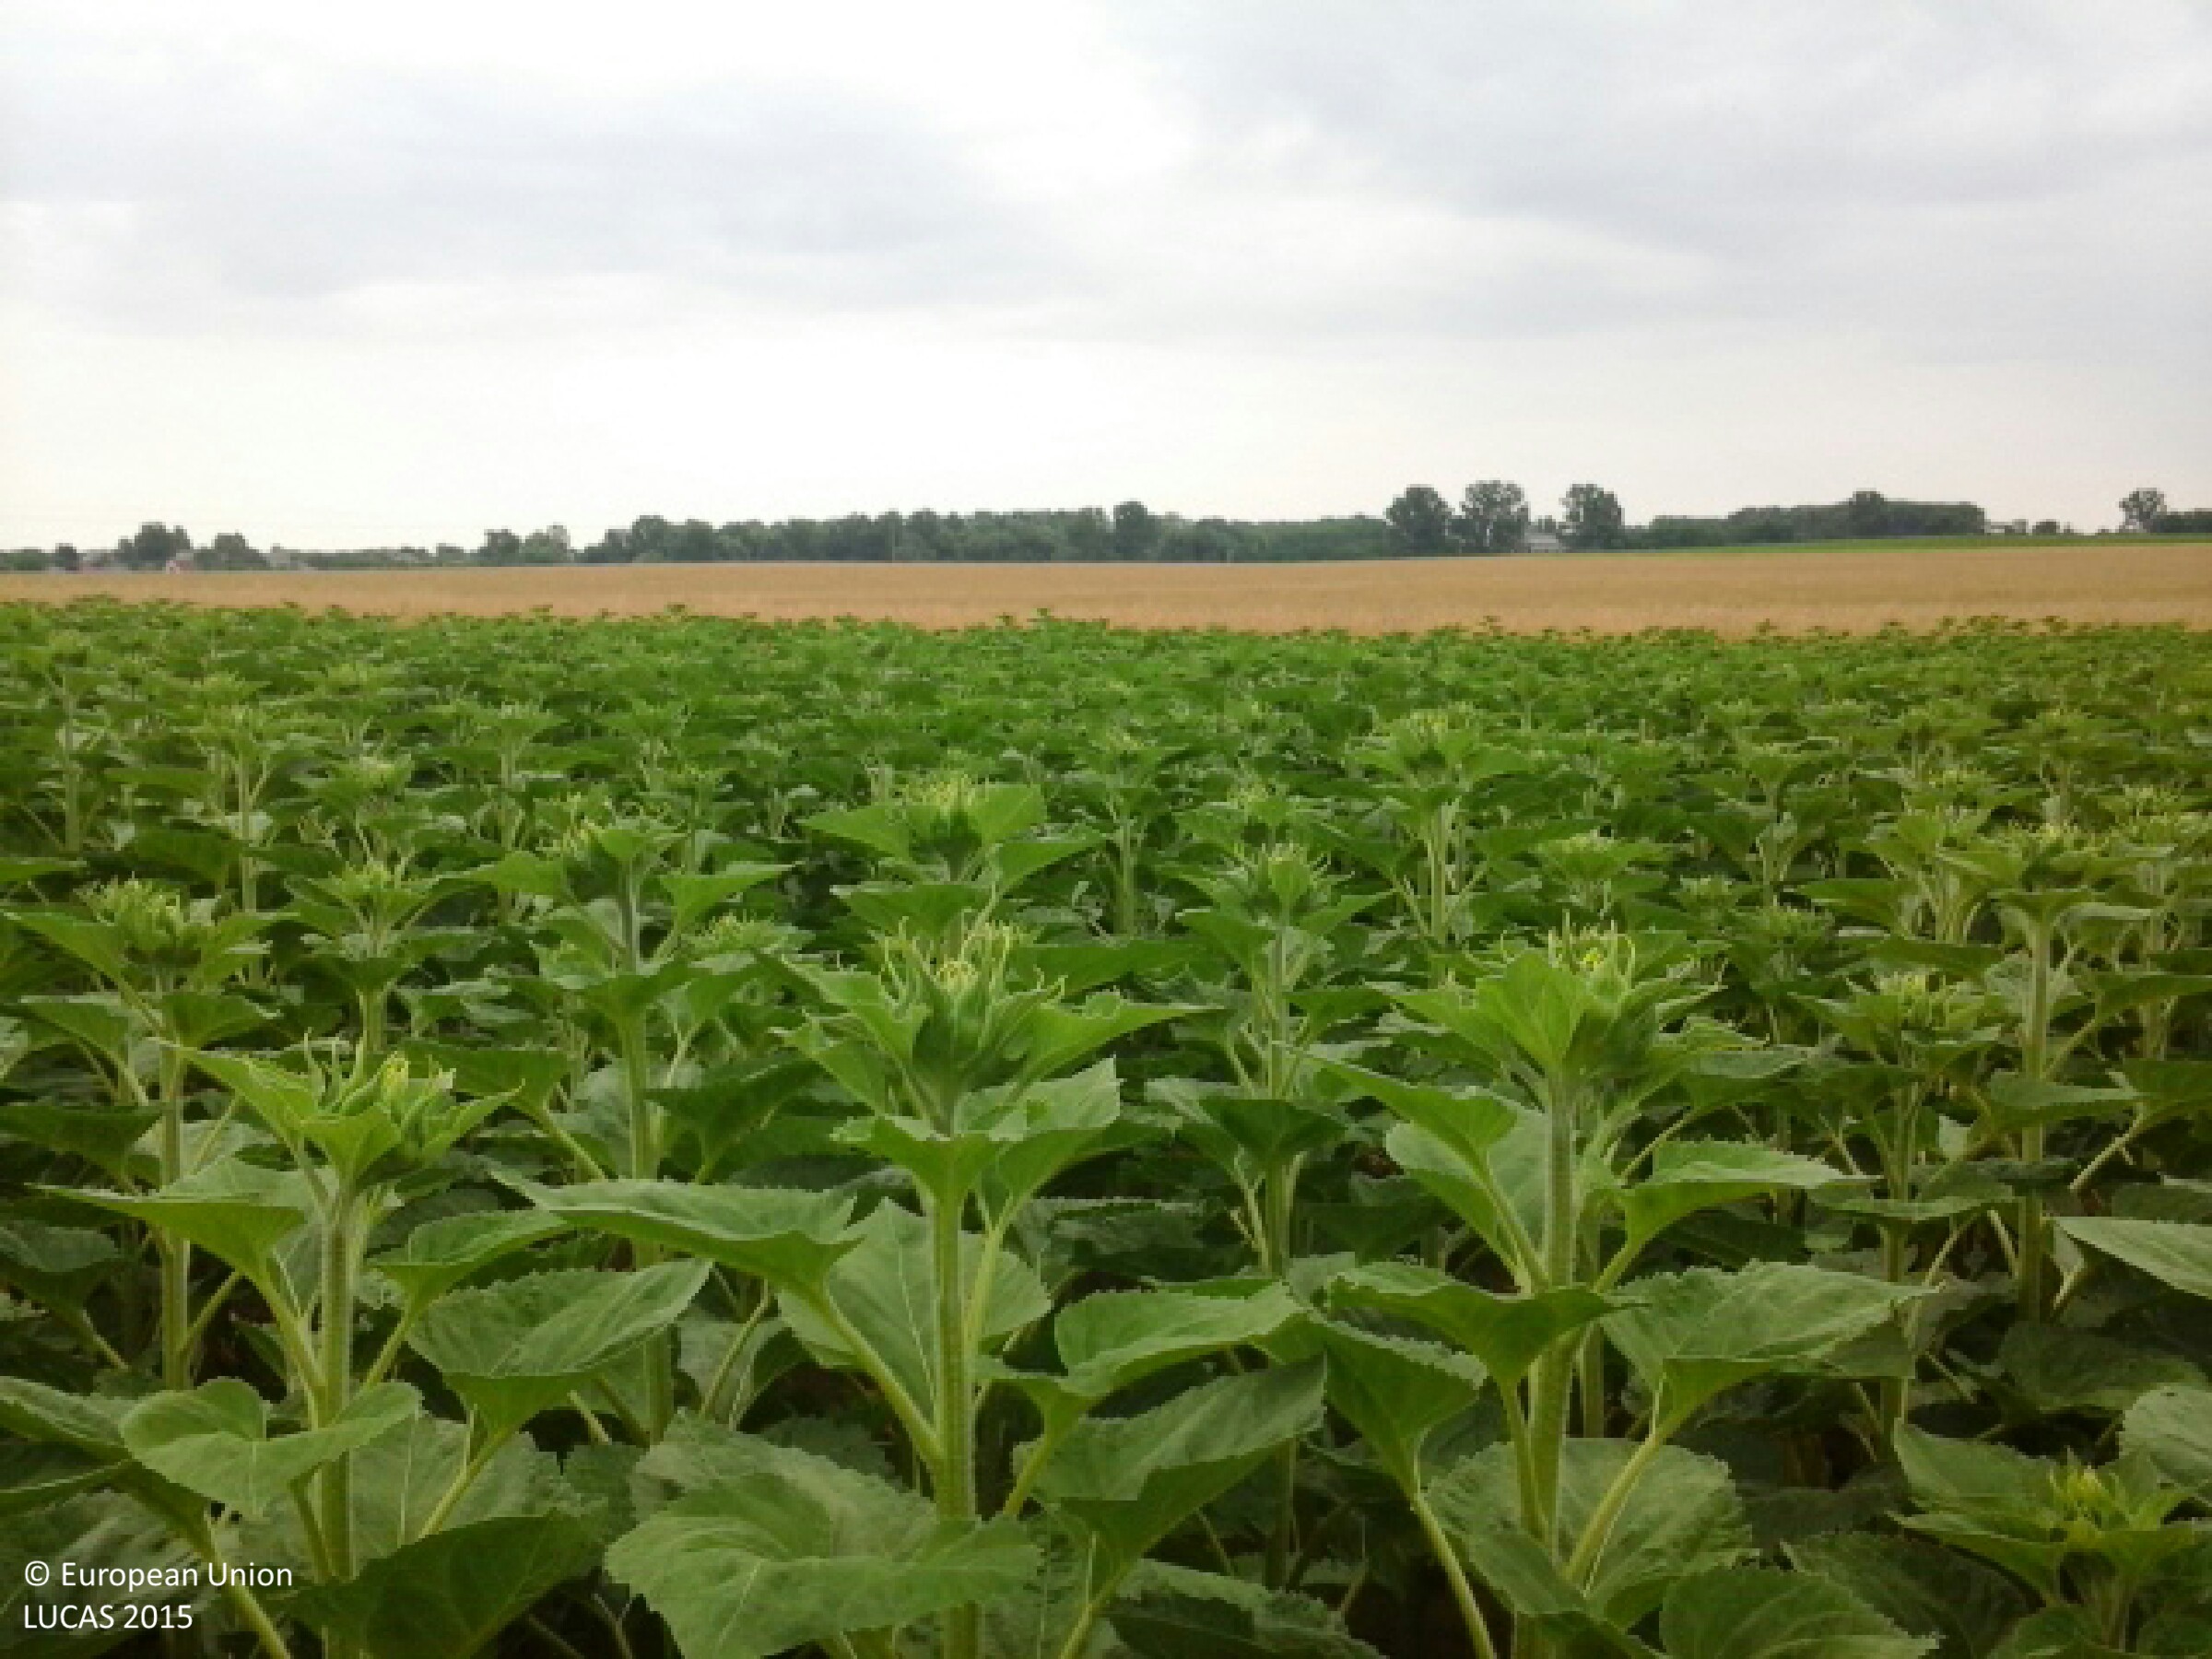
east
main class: Cropland
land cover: Sunflower
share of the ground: > 75 %
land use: Agriculture (excluding fallow land and kitchen gardens)
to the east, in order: Sunflower; Rape and turnip rape
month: June
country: HU
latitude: 48.1604
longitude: 21.5411
